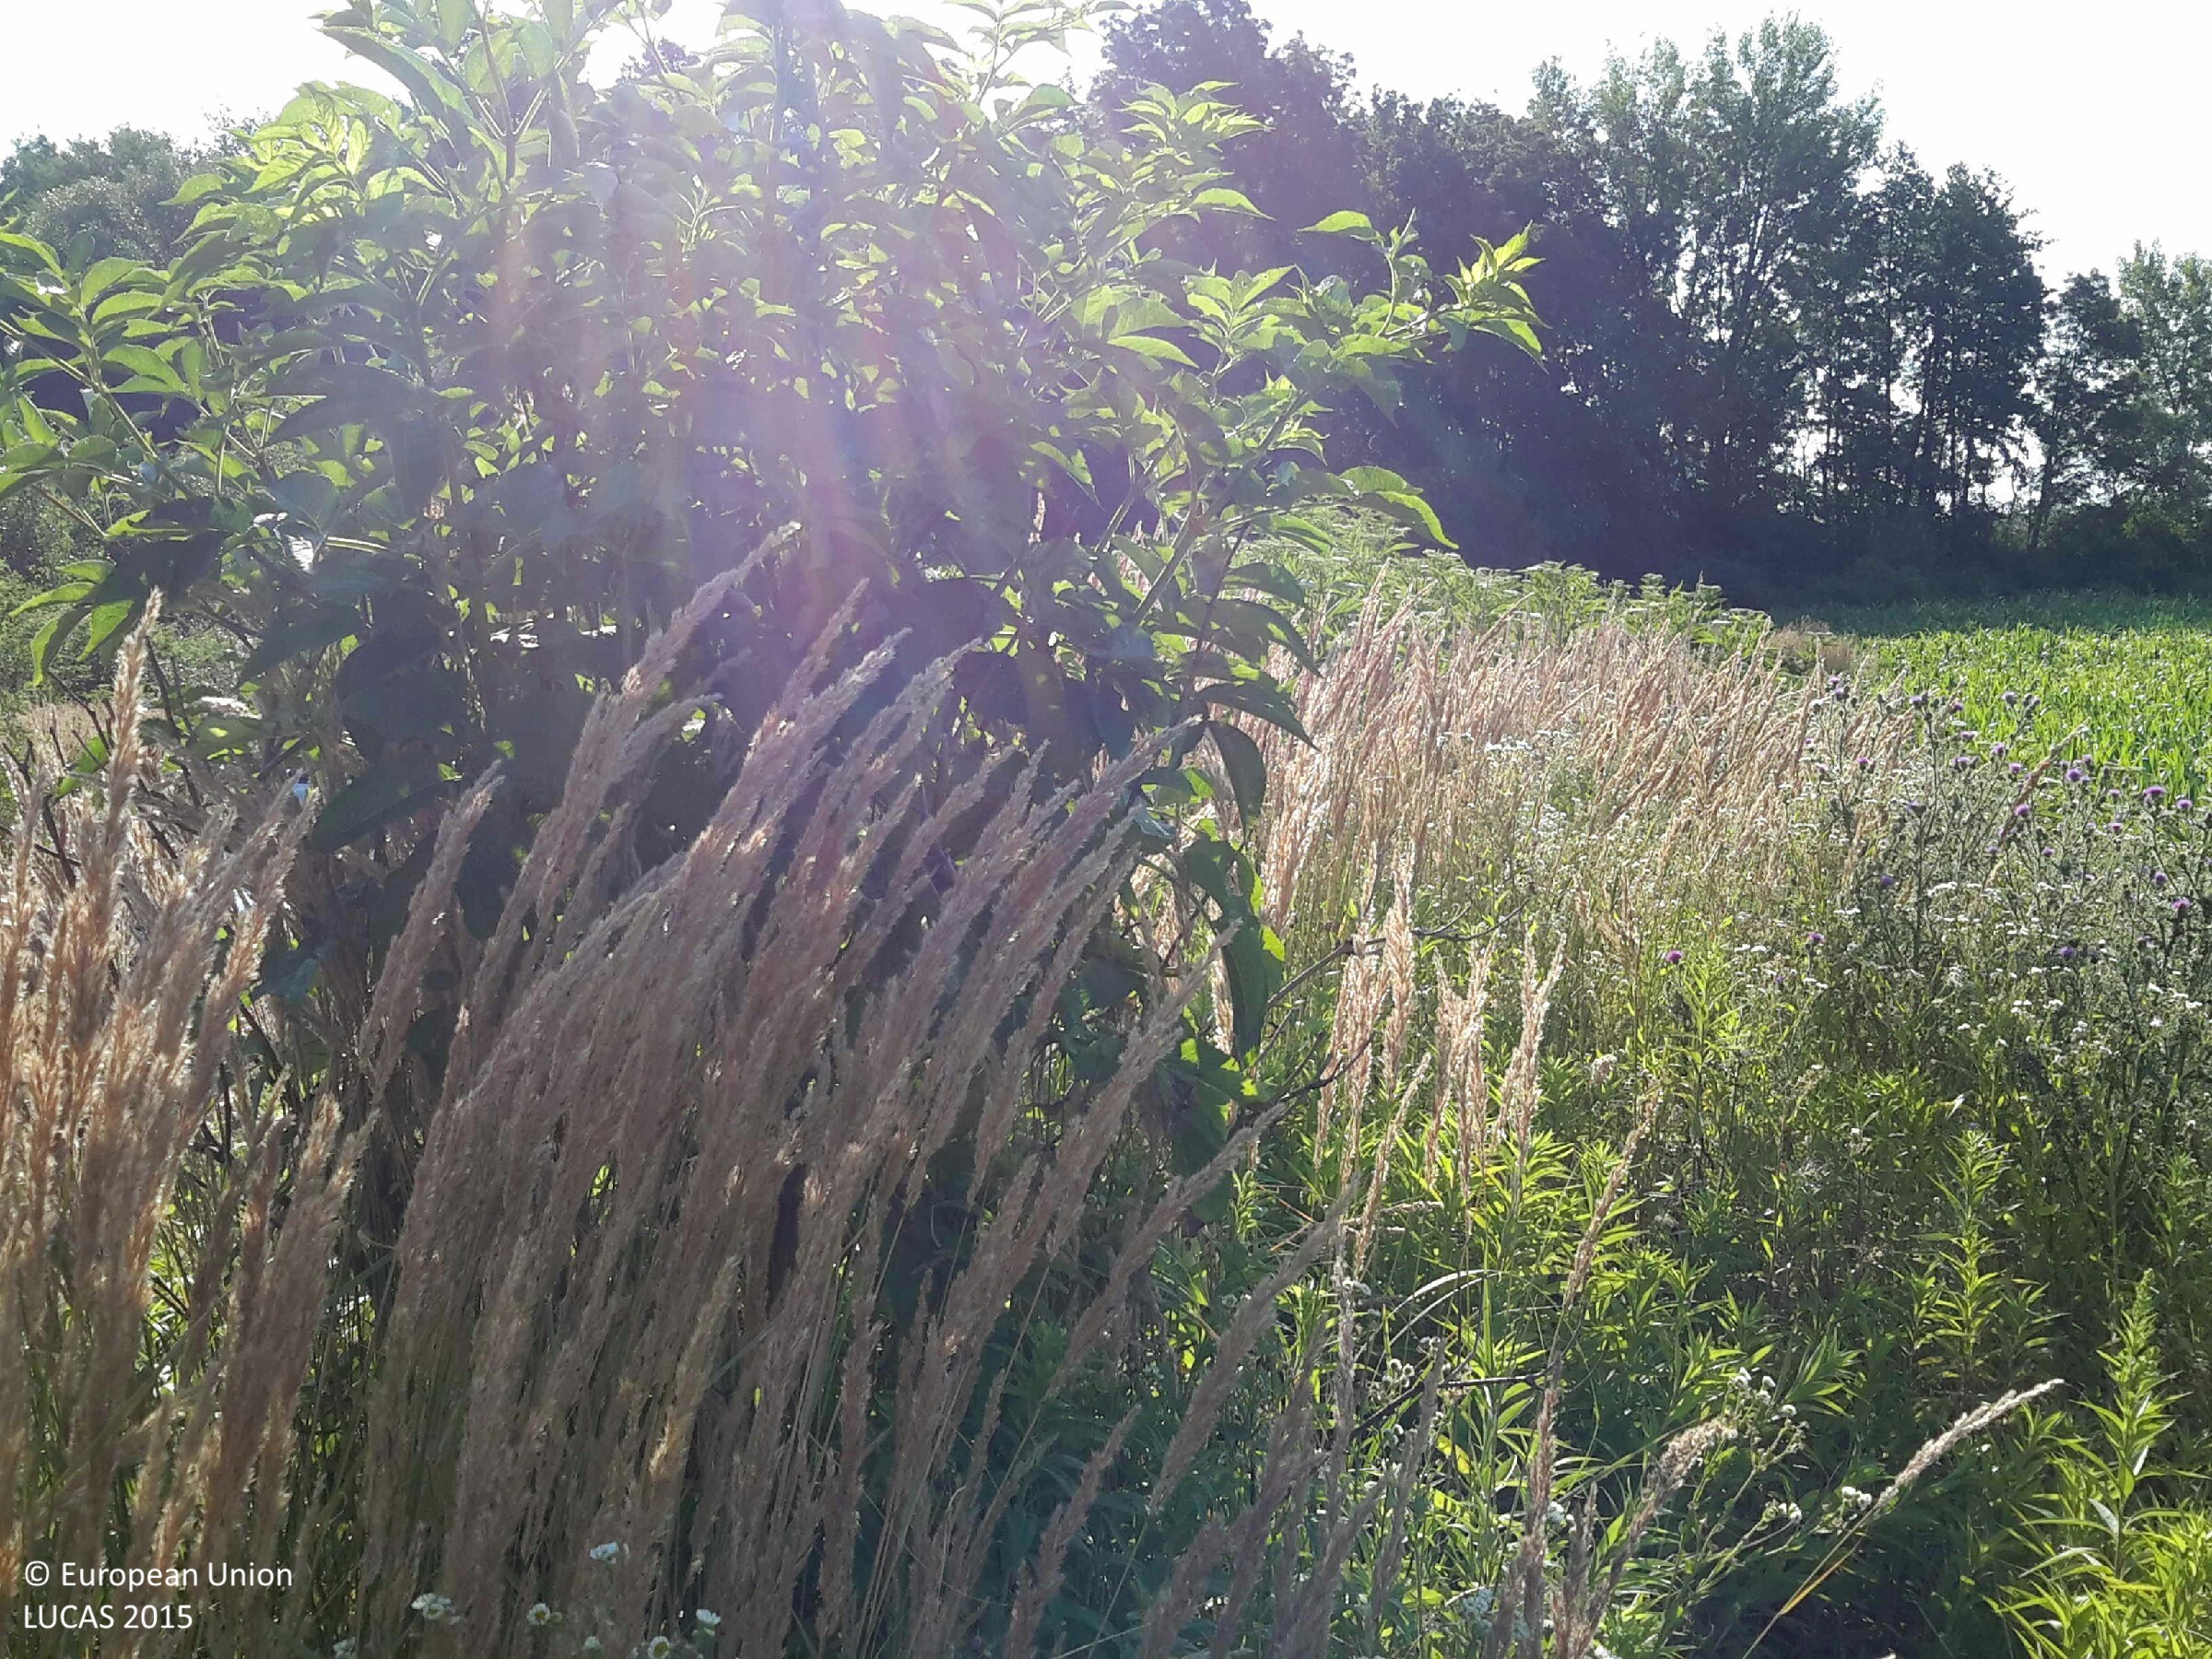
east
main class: Grassland
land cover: Grassland with sparse tree/shrub cover
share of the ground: > 75 %
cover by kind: herbaceous plants 90 %, broadleaved forest trees 5 %, shrubs 5 %
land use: Semi-natural and natural areas not in use
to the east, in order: Grassland with sparse tree/shrub cover; Tracks; Abandoned hedges; Tracks; Other mixed woodland; Maize
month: July
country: HU
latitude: 47.5437
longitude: 17.0878
